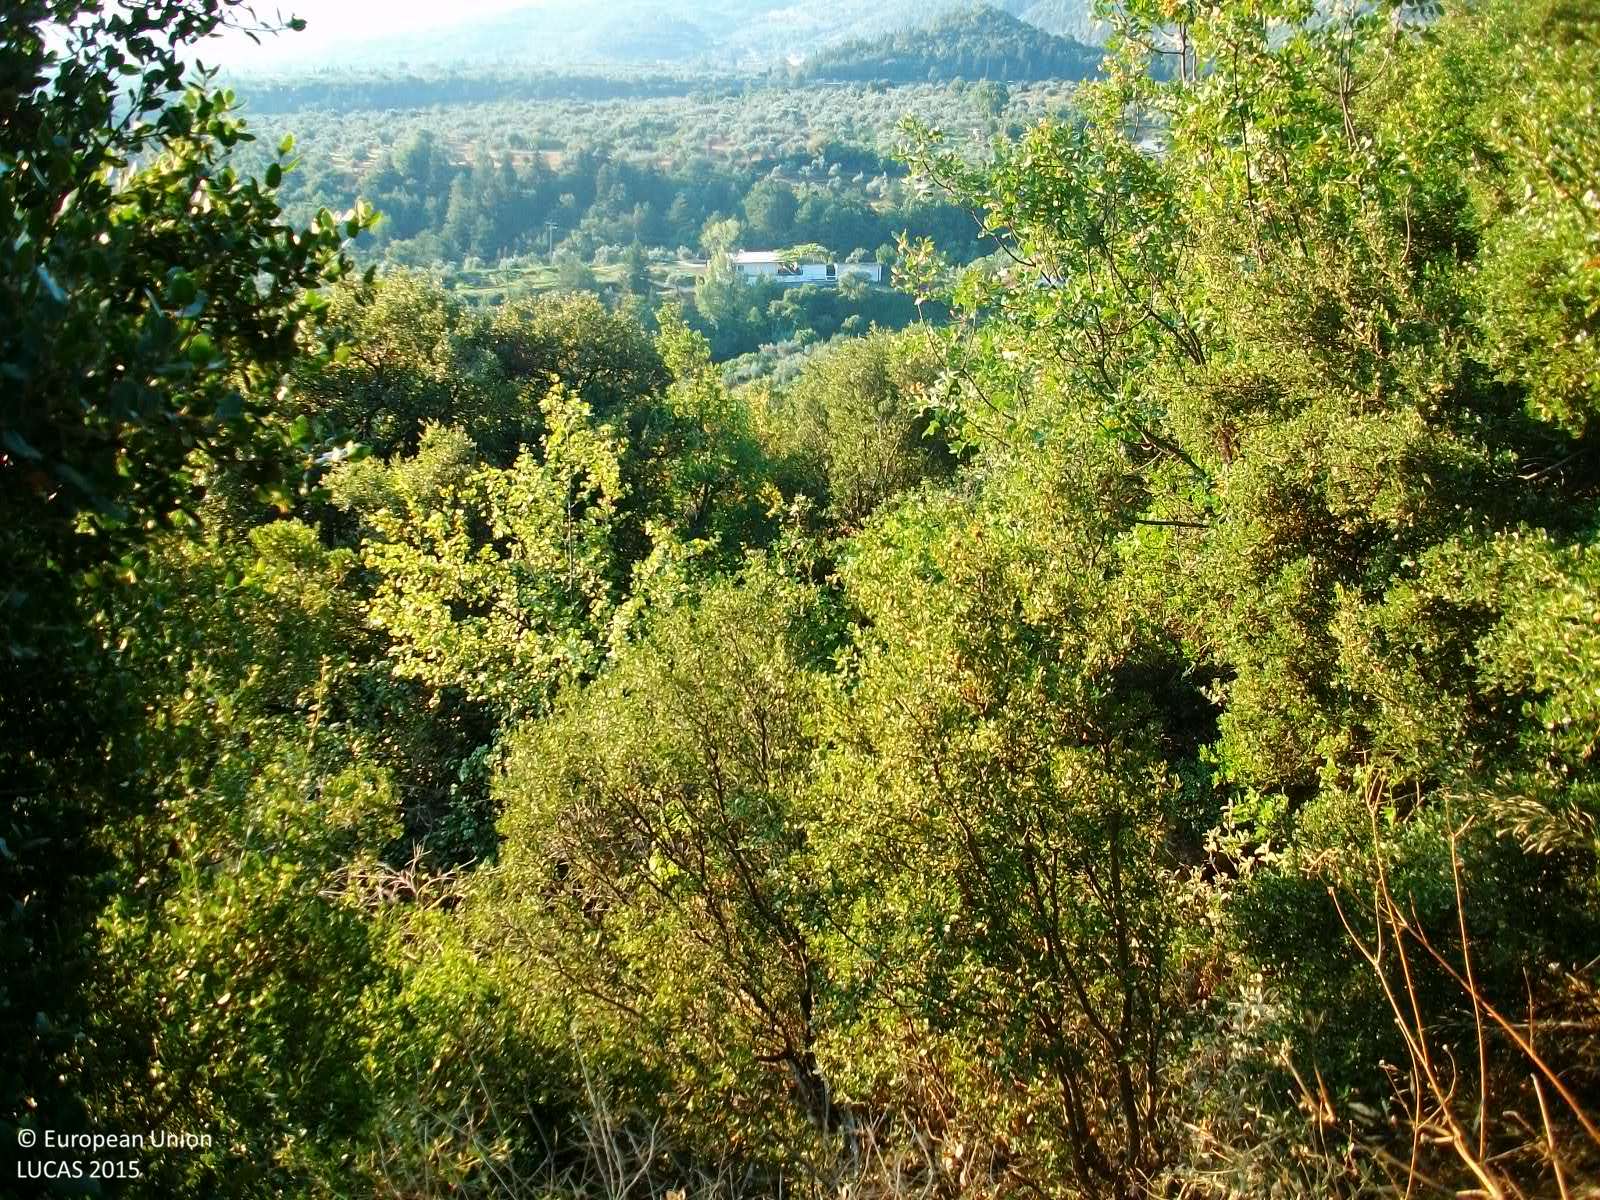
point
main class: Shrubland
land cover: Shrubland without tree cover
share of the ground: > 75 %
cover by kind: shrubs 100 %
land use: Semi-natural and natural areas not in use
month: August
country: GR
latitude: 37.1852
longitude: 22.2912
